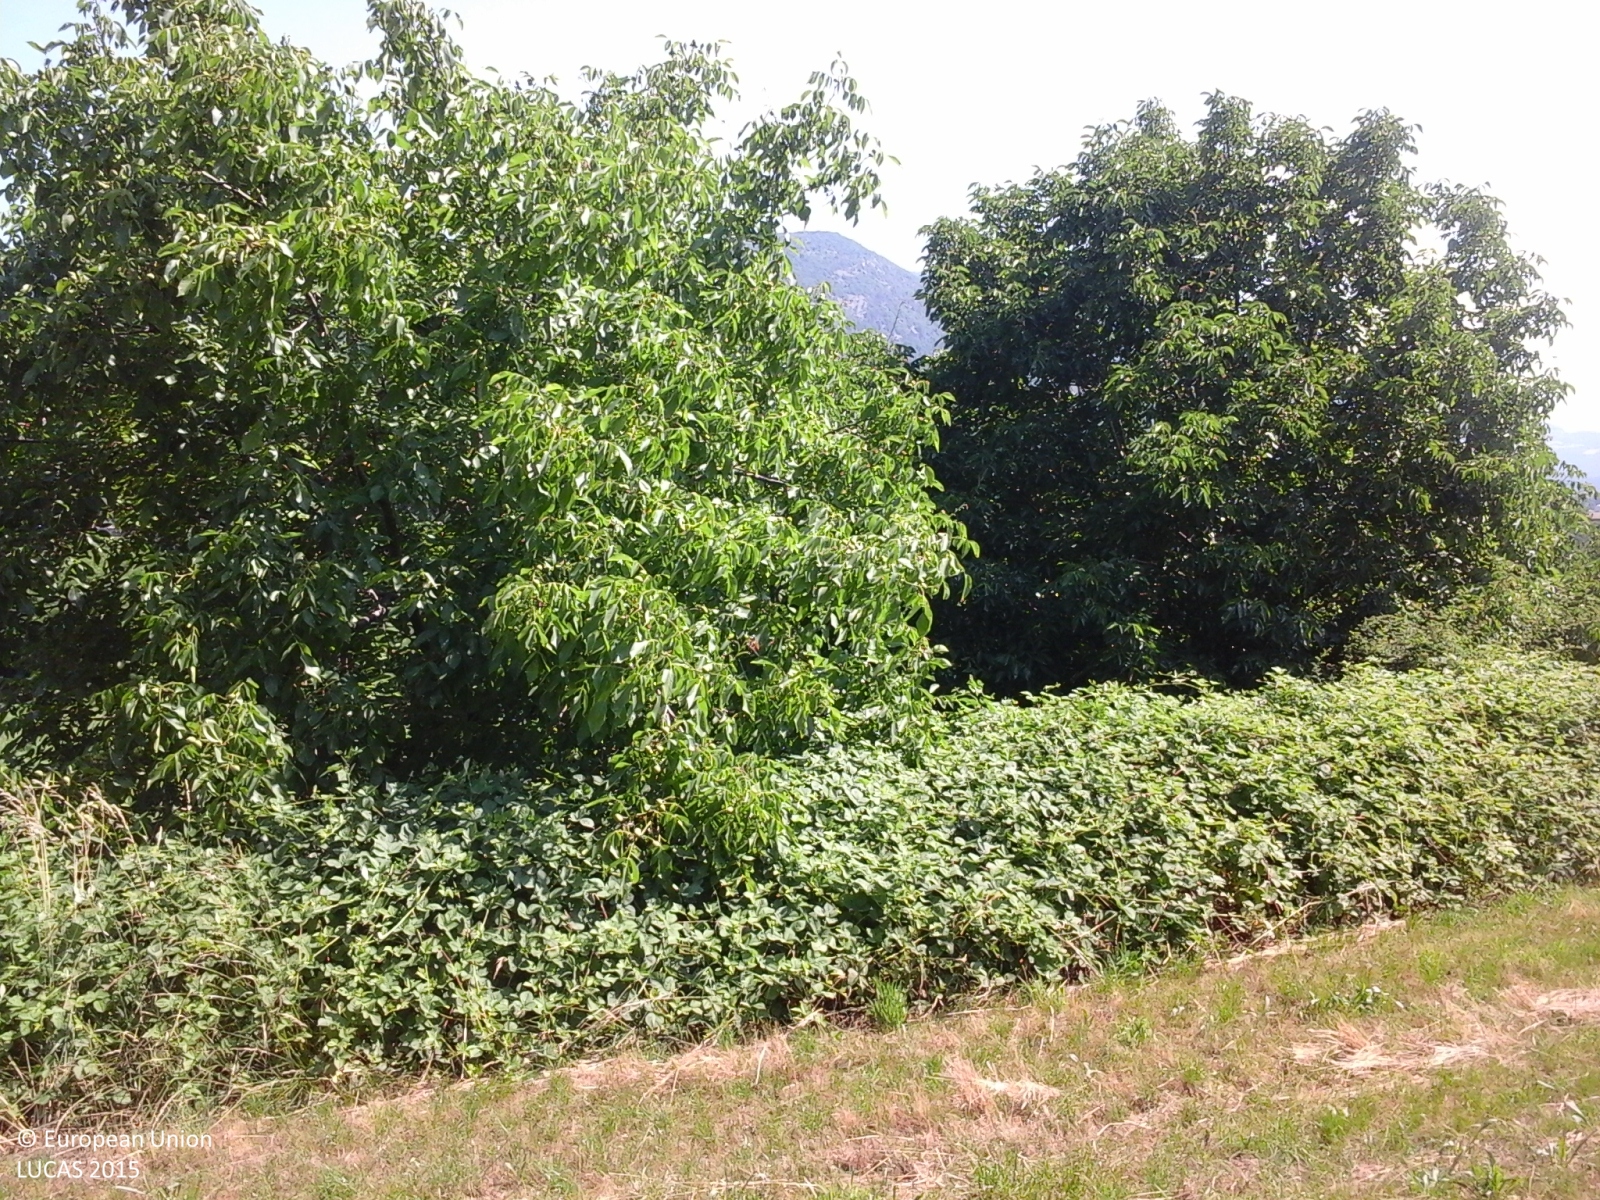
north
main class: Grassland
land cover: Grassland without tree/shrub cover
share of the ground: > 75 %
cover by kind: herbaceous plants 100 %
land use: Agriculture (excluding fallow land and kitchen gardens)
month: June
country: IT
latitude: 45.5920
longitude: 10.7294
